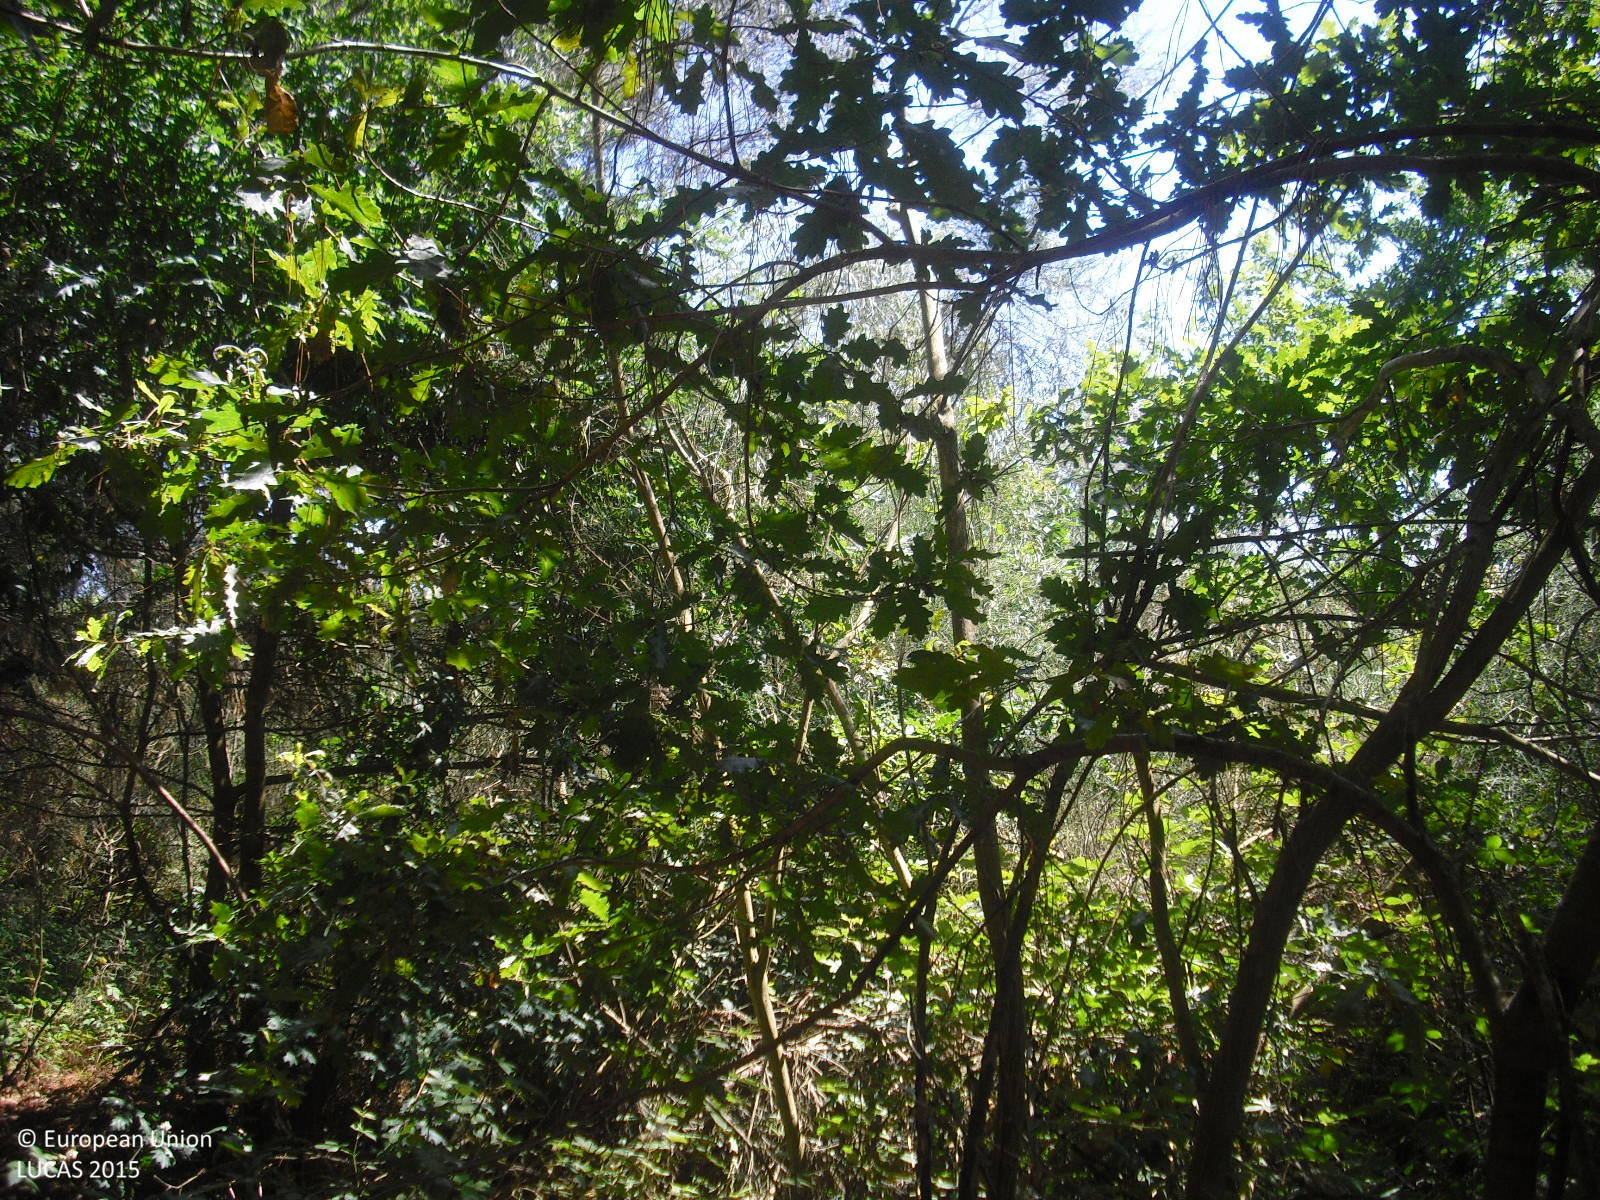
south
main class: Shrubland
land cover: Shrubland with sparse tree cover
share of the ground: > 75 %
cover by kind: shrubs 95 %, broadleaved forest trees 5 %
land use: Abandoned areas
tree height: < 5 m
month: July
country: ES
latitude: 42.6555
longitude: -7.5535
